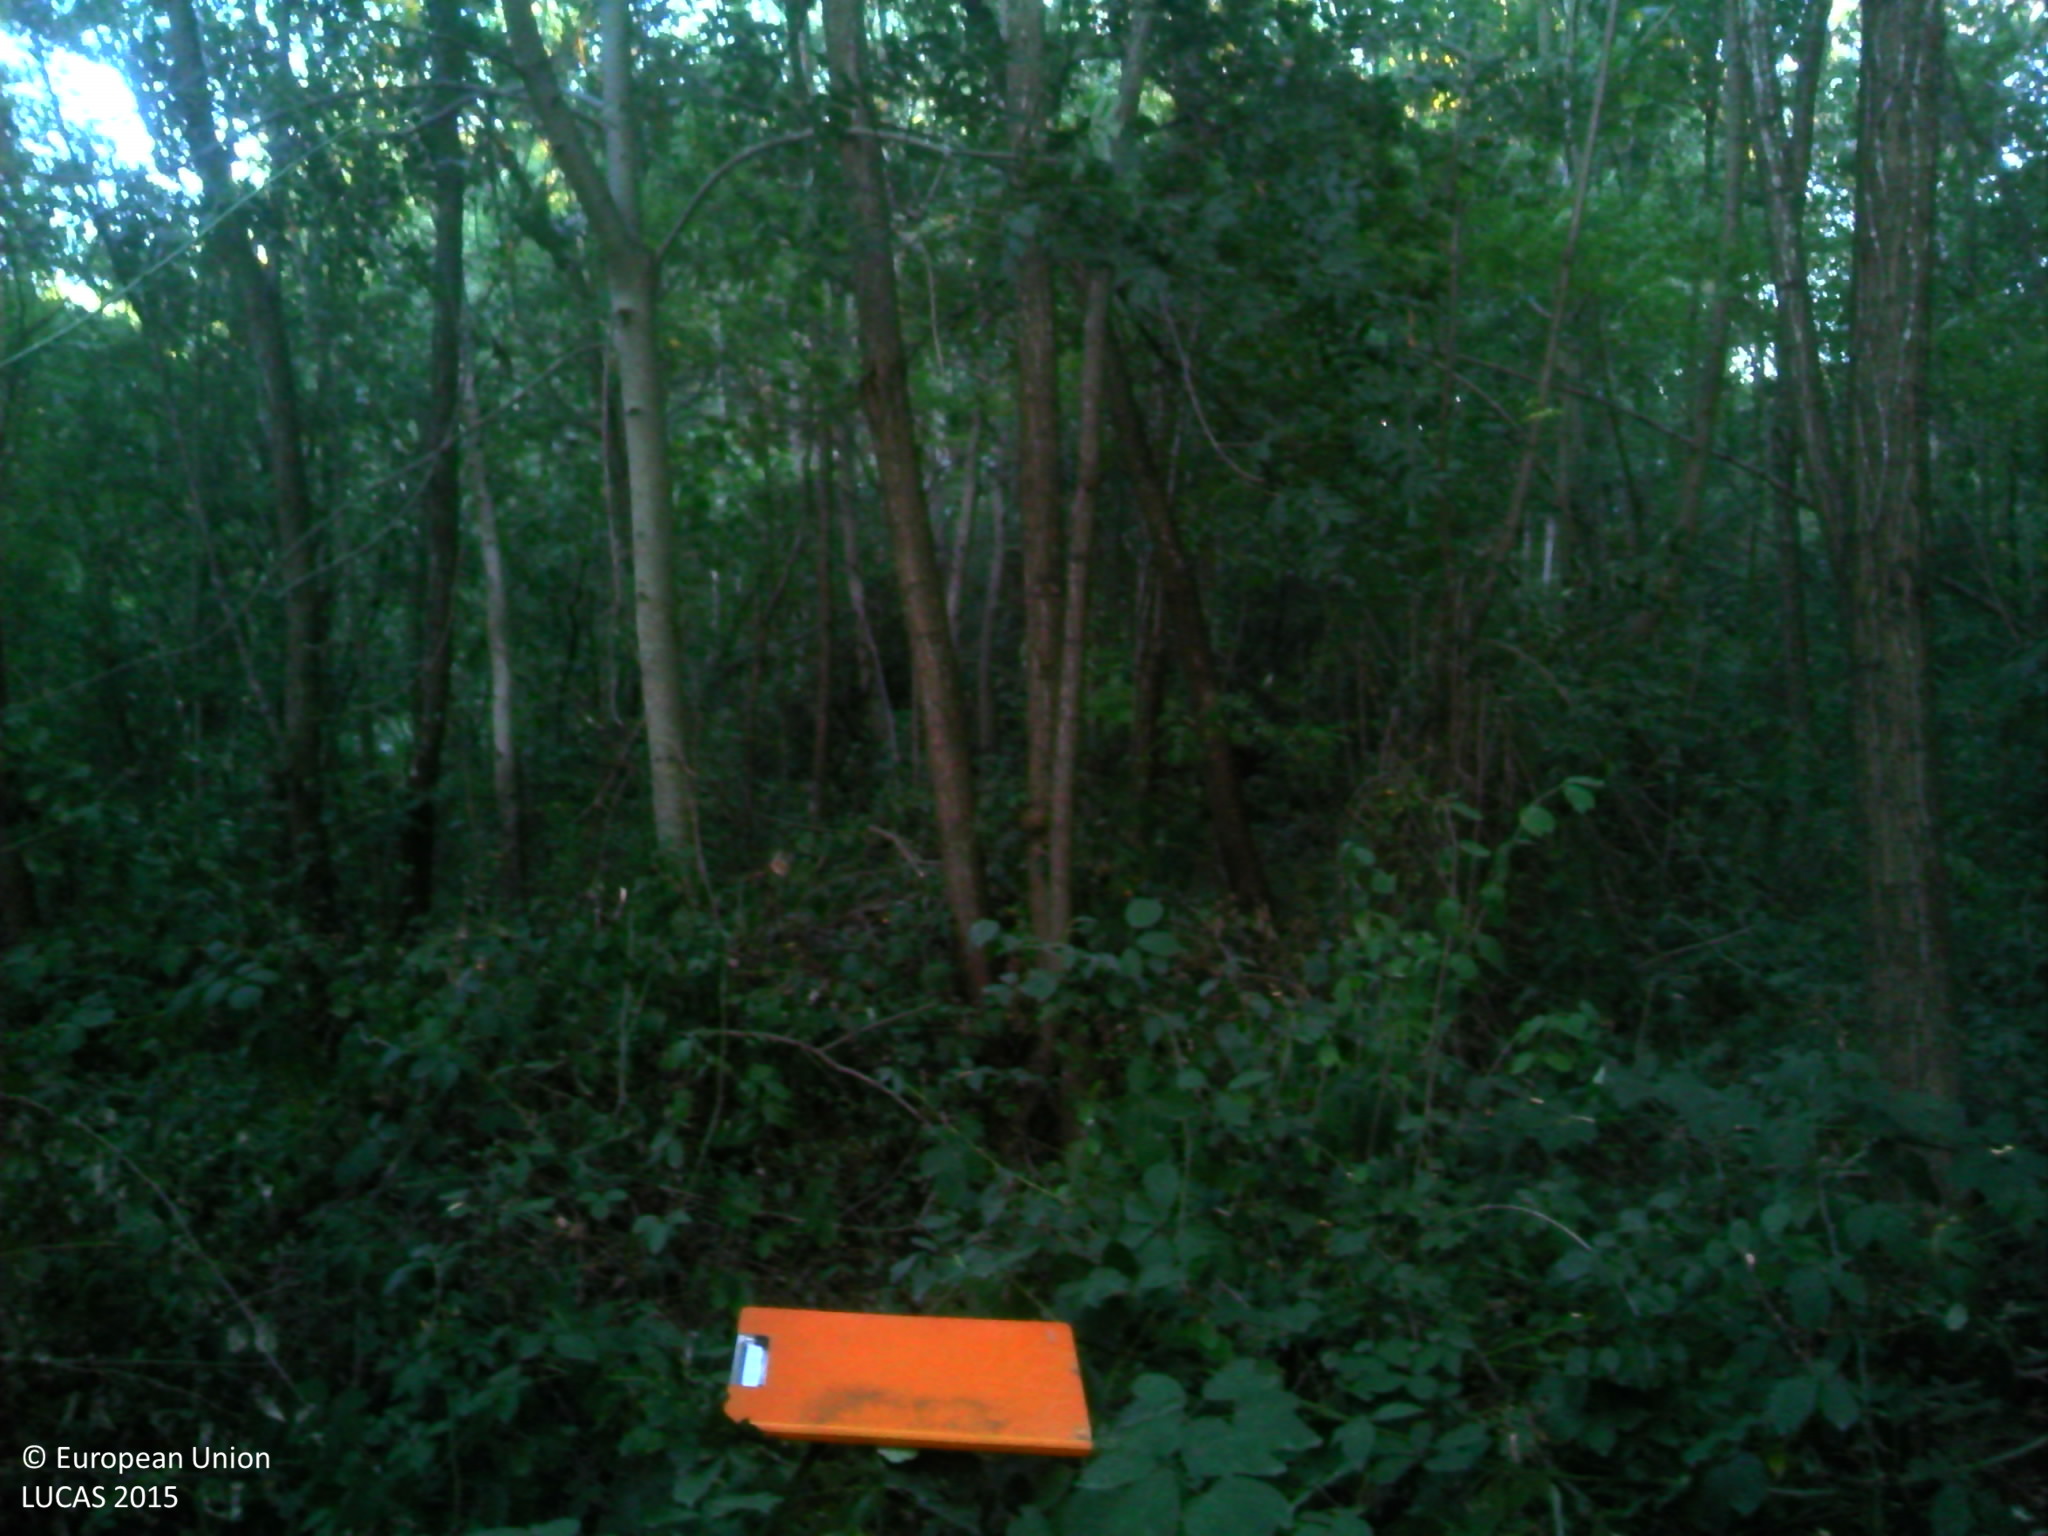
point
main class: Woodland
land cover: Broadleaved woodland
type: mesophytic deciduous forest
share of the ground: > 75 %
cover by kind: broadleaved forest trees 80 %, herbaceous plants 20 %
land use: Forestry
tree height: > 5 m
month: September
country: FR
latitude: 45.2067
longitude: 5.0270
